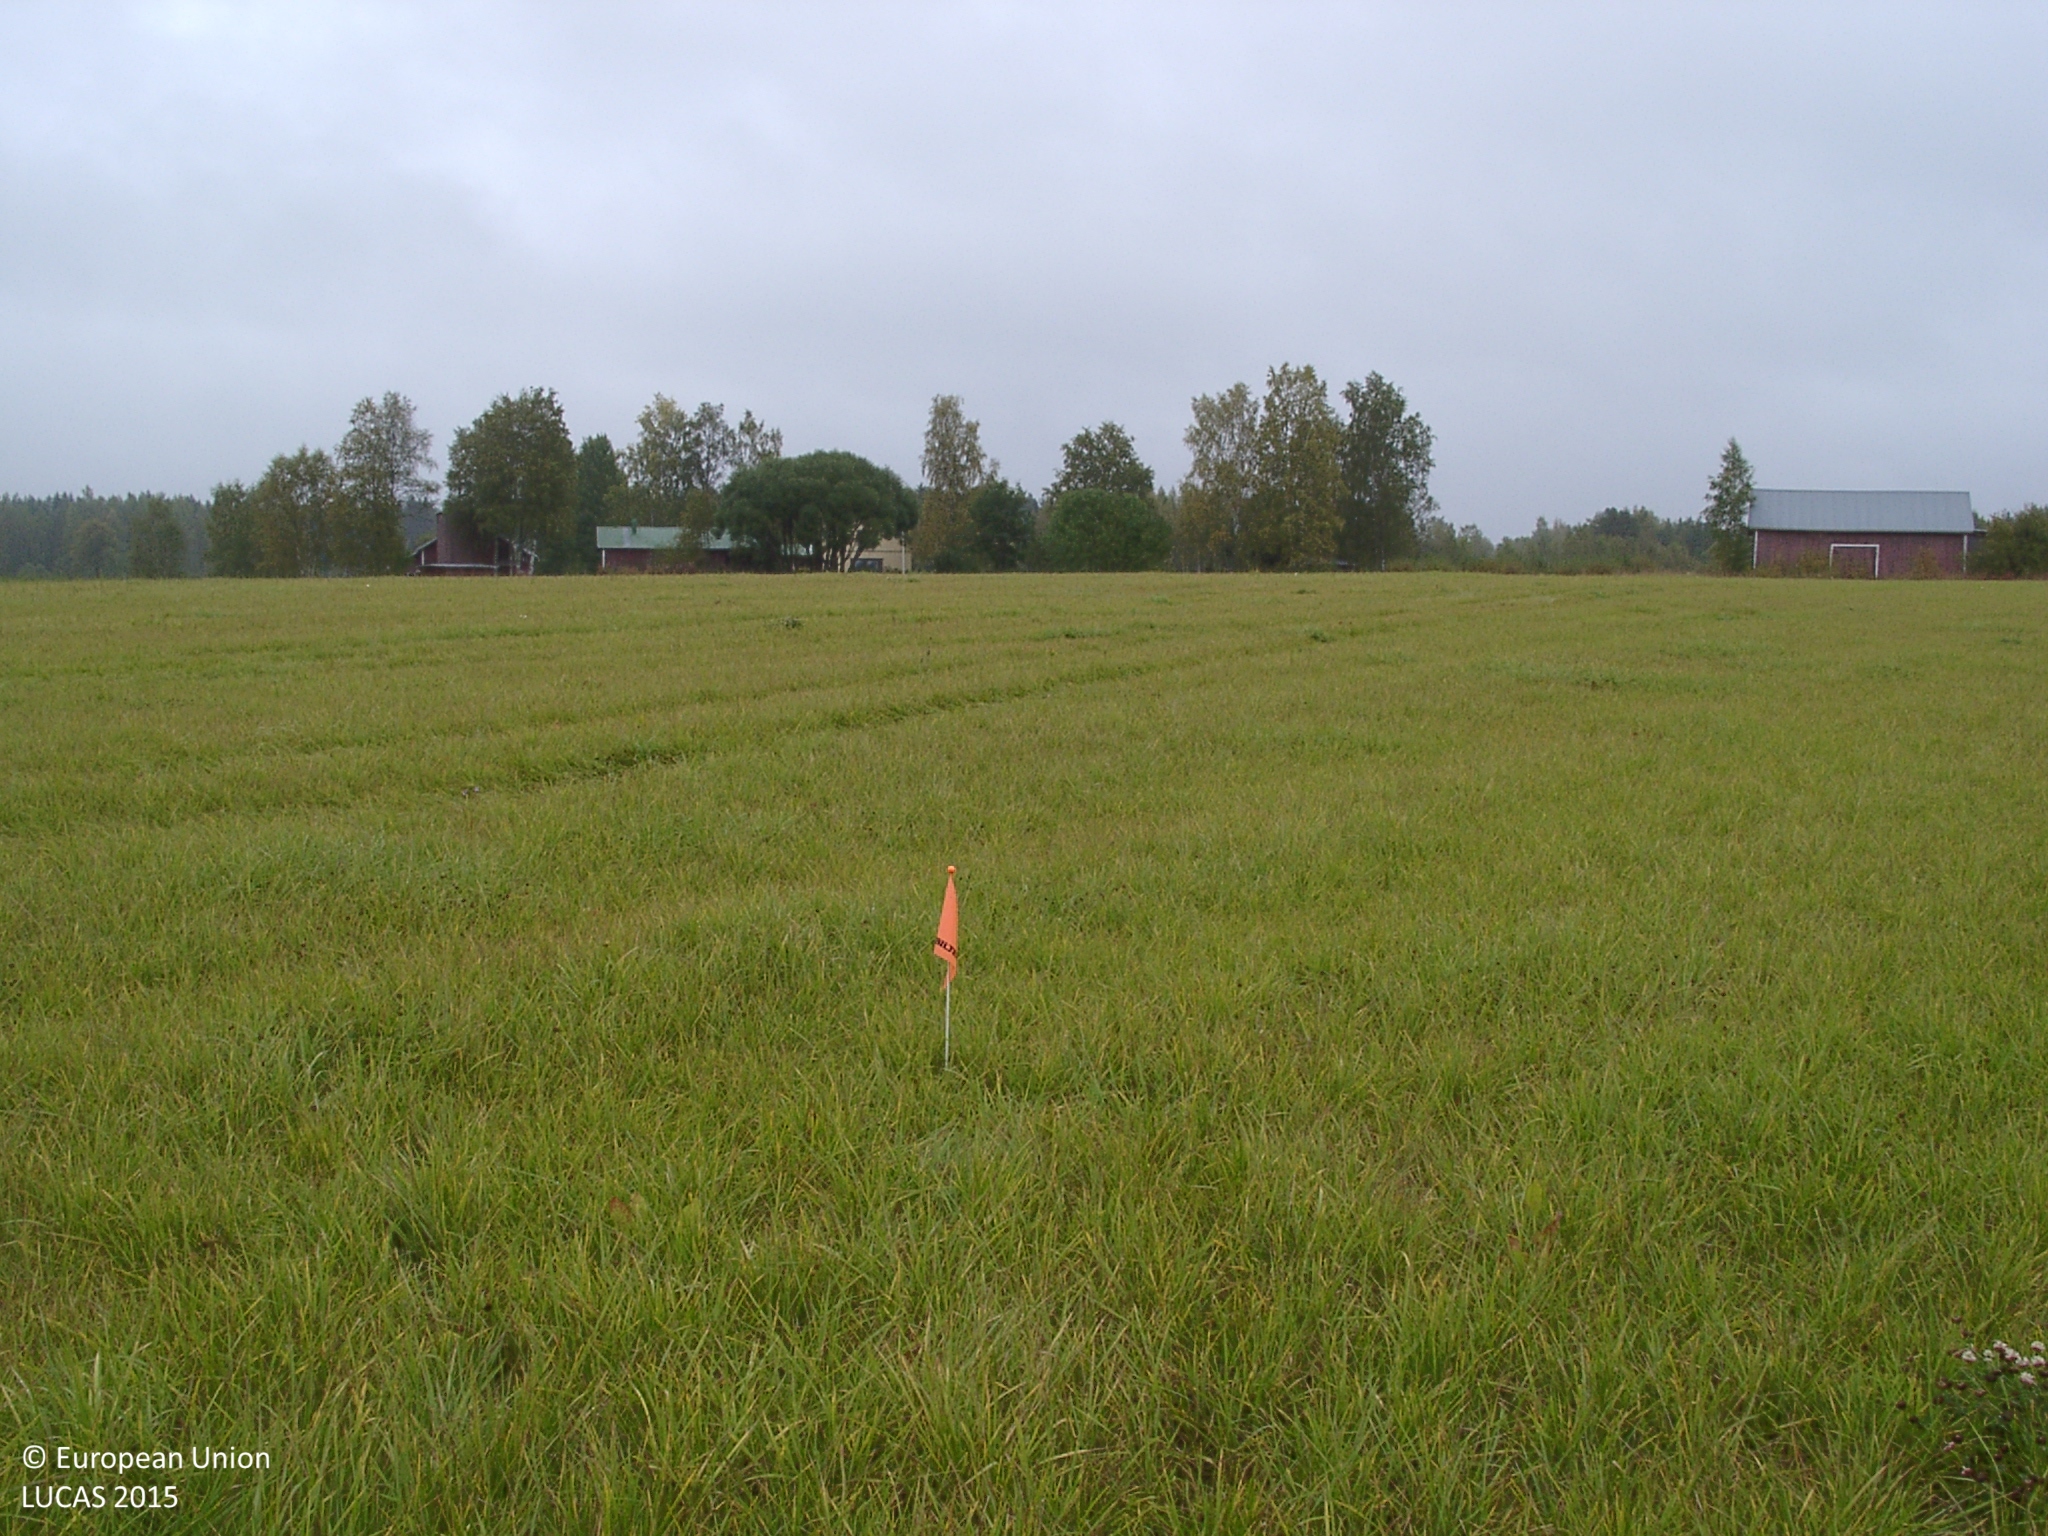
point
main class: Cropland
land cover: Temporary grasslands
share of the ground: > 75 %
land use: Agriculture (excluding fallow land and kitchen gardens)
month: September
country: FI
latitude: 62.5646
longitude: 25.6194
